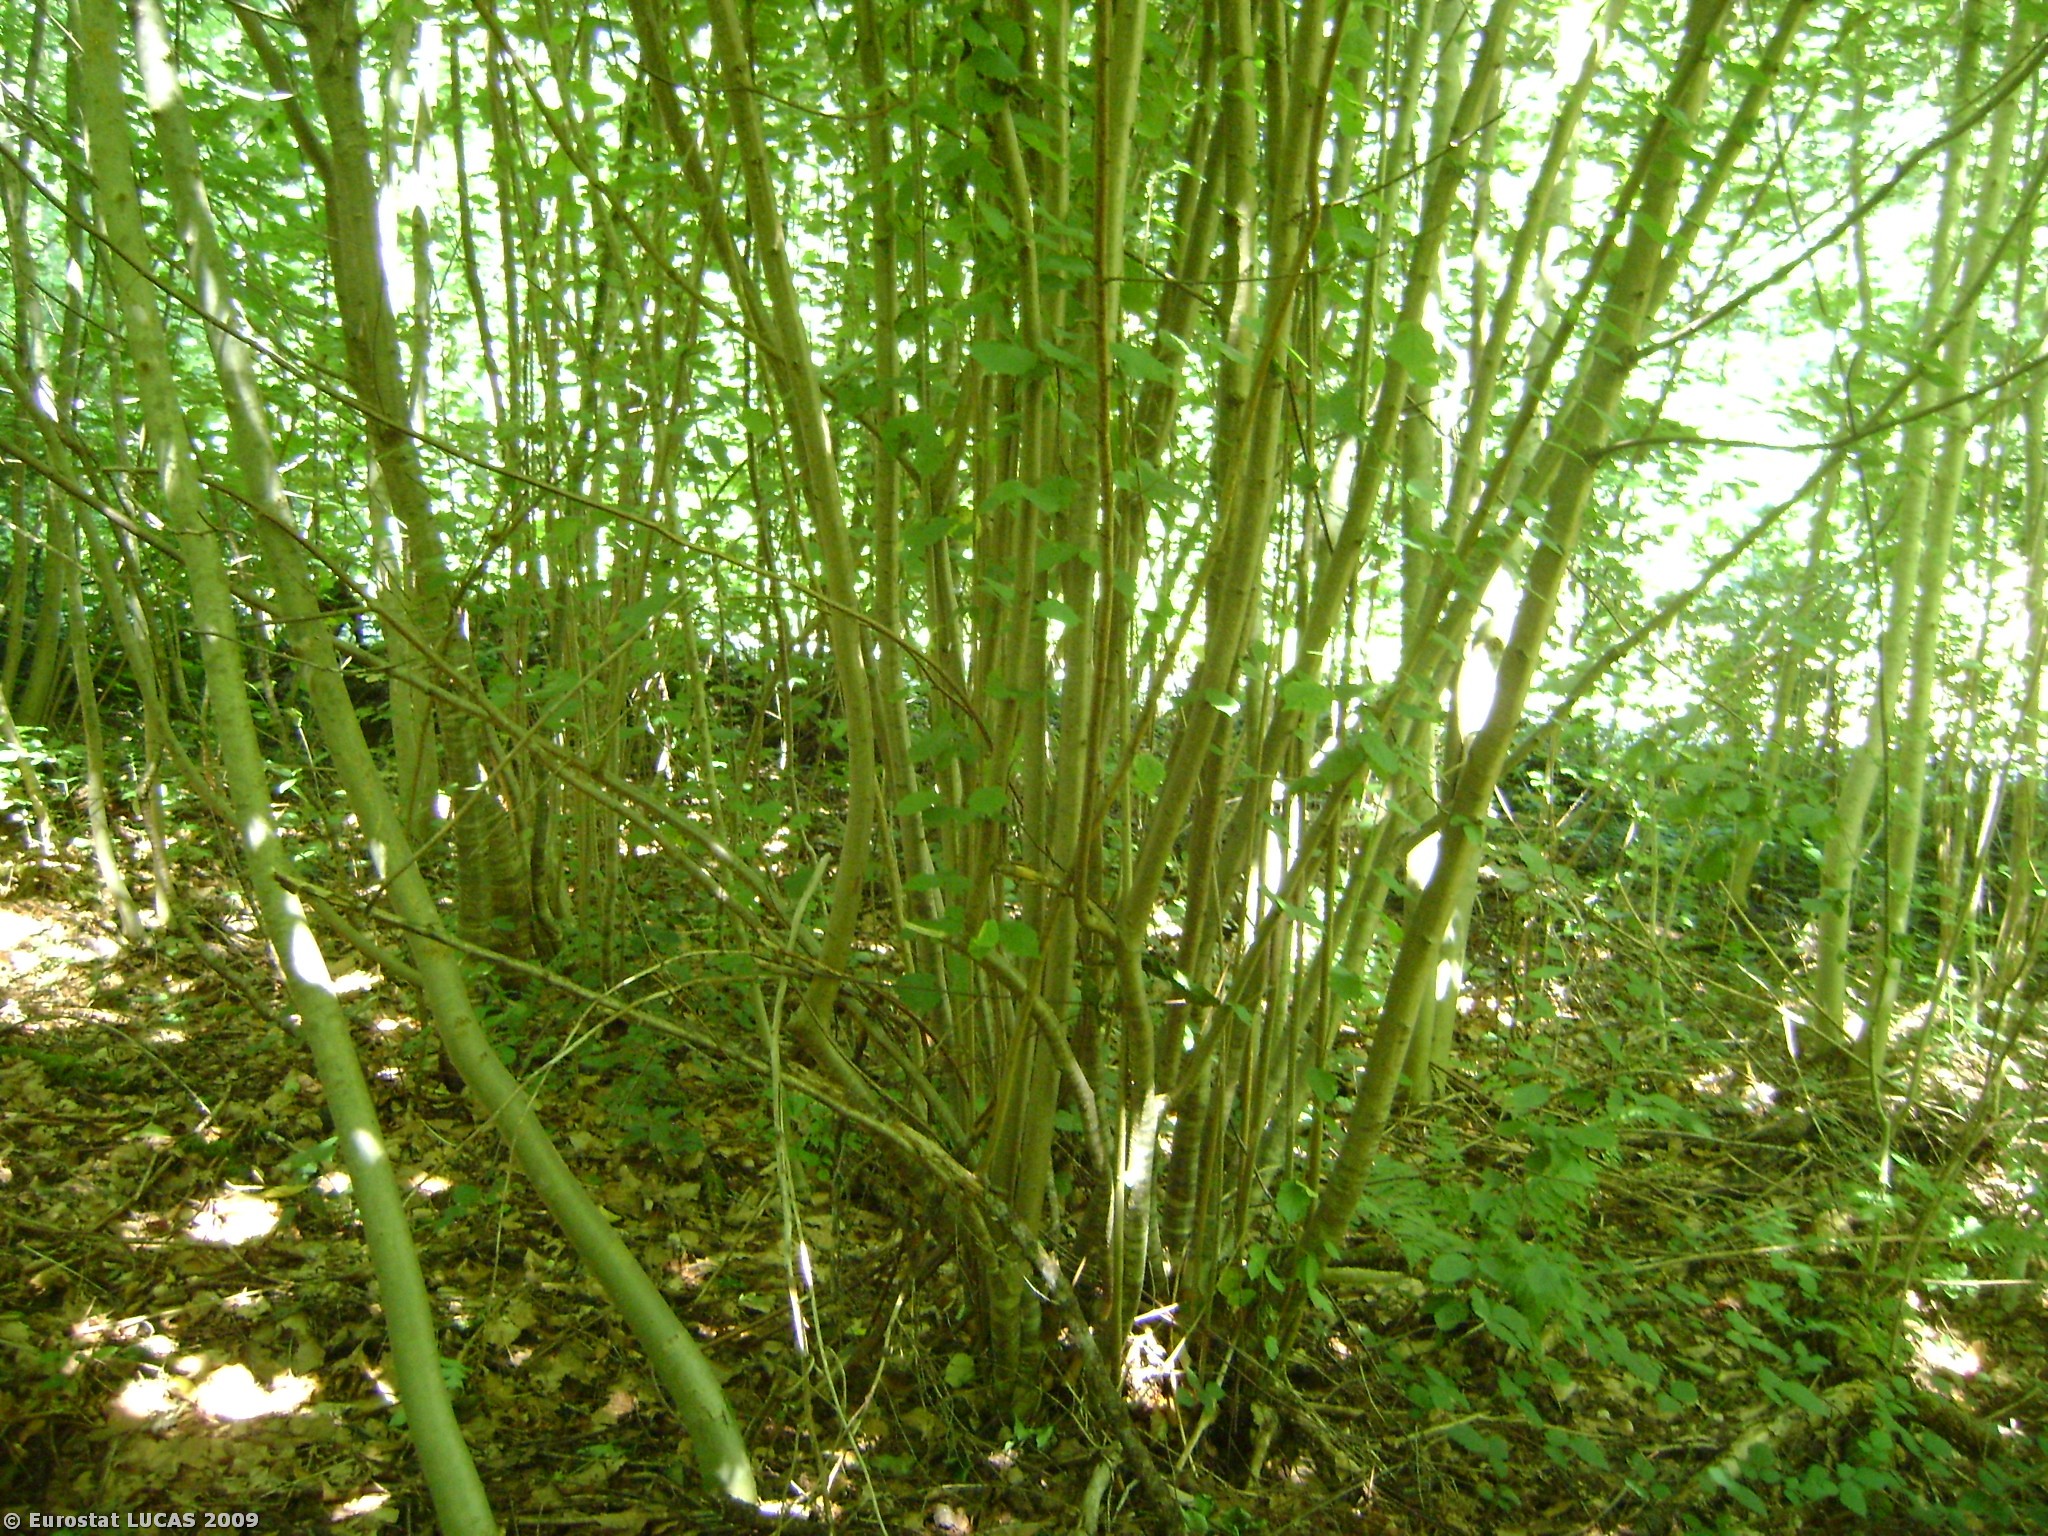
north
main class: Woodland
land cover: Broadleaved woodland
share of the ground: > 75 %
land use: Forestry
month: July
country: AT
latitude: 47.1971
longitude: 9.6703
